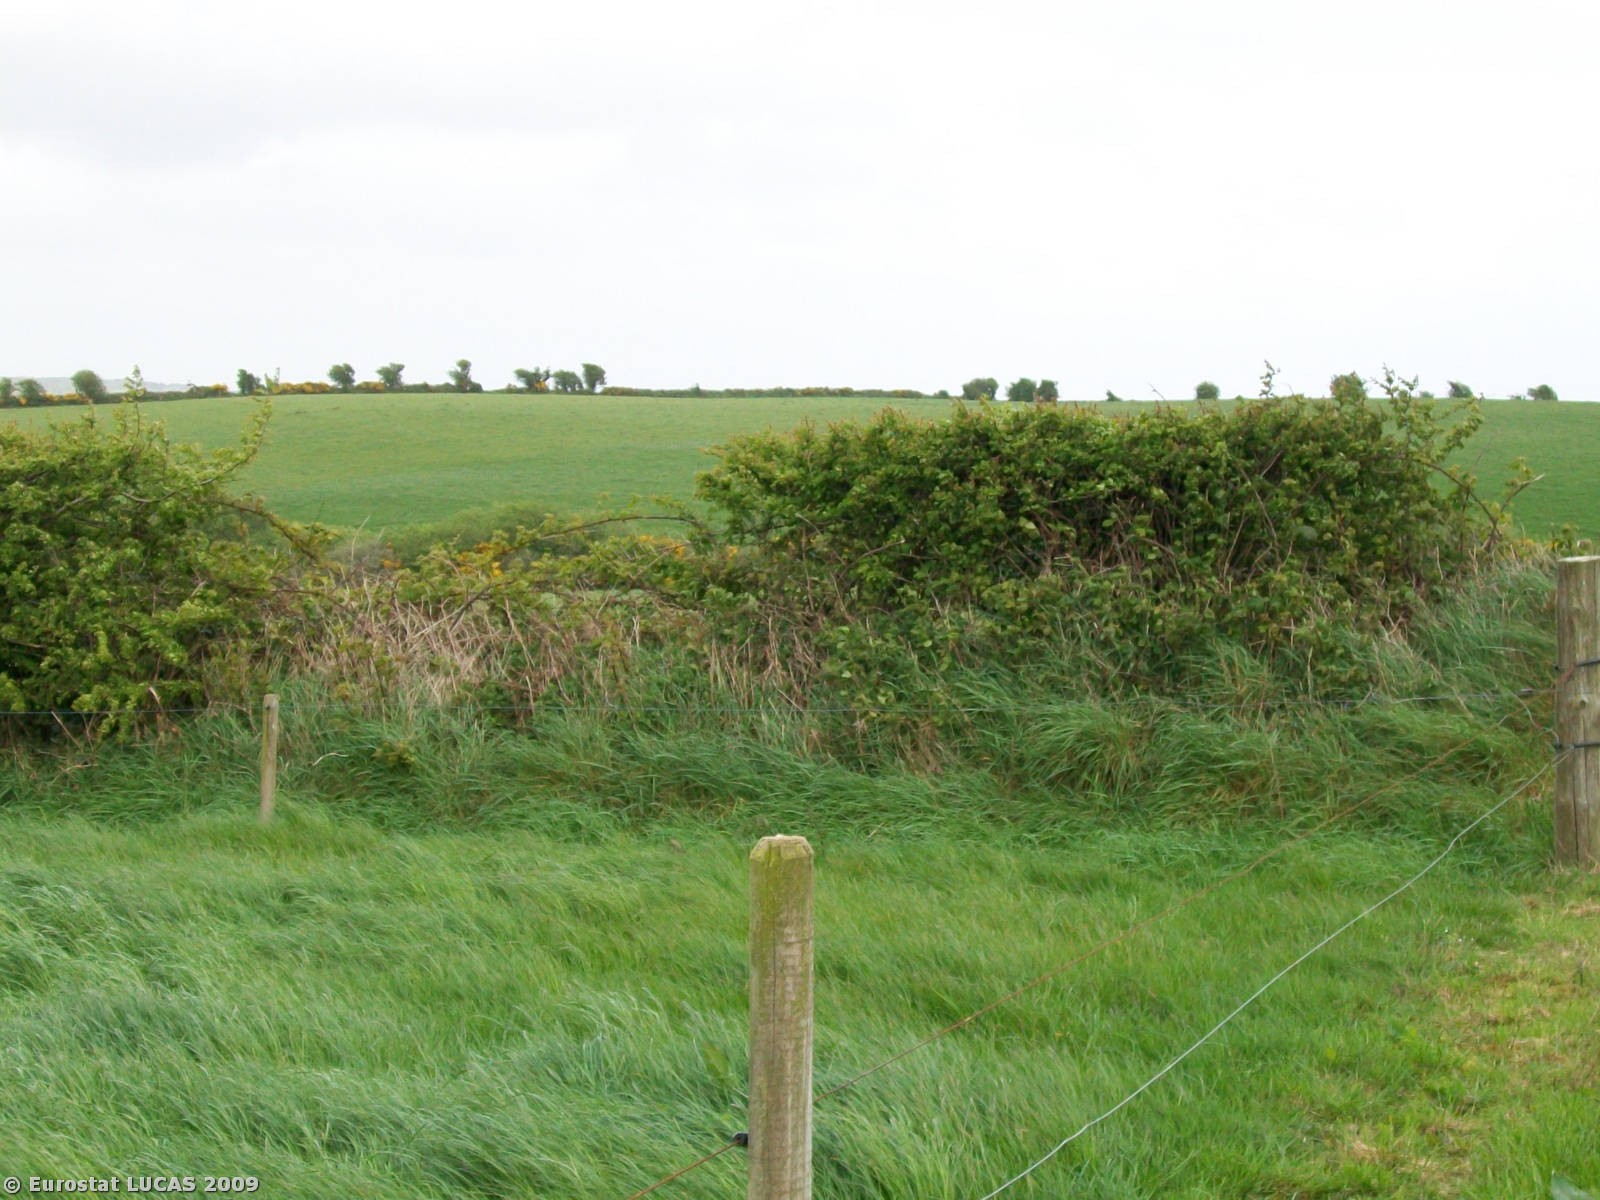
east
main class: Grassland
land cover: Grassland without tree/shrub cover
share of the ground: > 75 %
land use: Agriculture (excluding fallow land and kitchen gardens)
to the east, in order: Grassland without tree/shrub cover; Fences; Managed hedges; Fences; Tracks; Fences; Grassland without tree/shrub cover; Fences; Grassland without tree/shrub cover; Fences; Abandoned hedges; Grassland without tree/shrub cover; Fences; Tracks; Fences; Grassland without tree/shrub cover
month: May
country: IE
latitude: 51.7456
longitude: -8.6668
